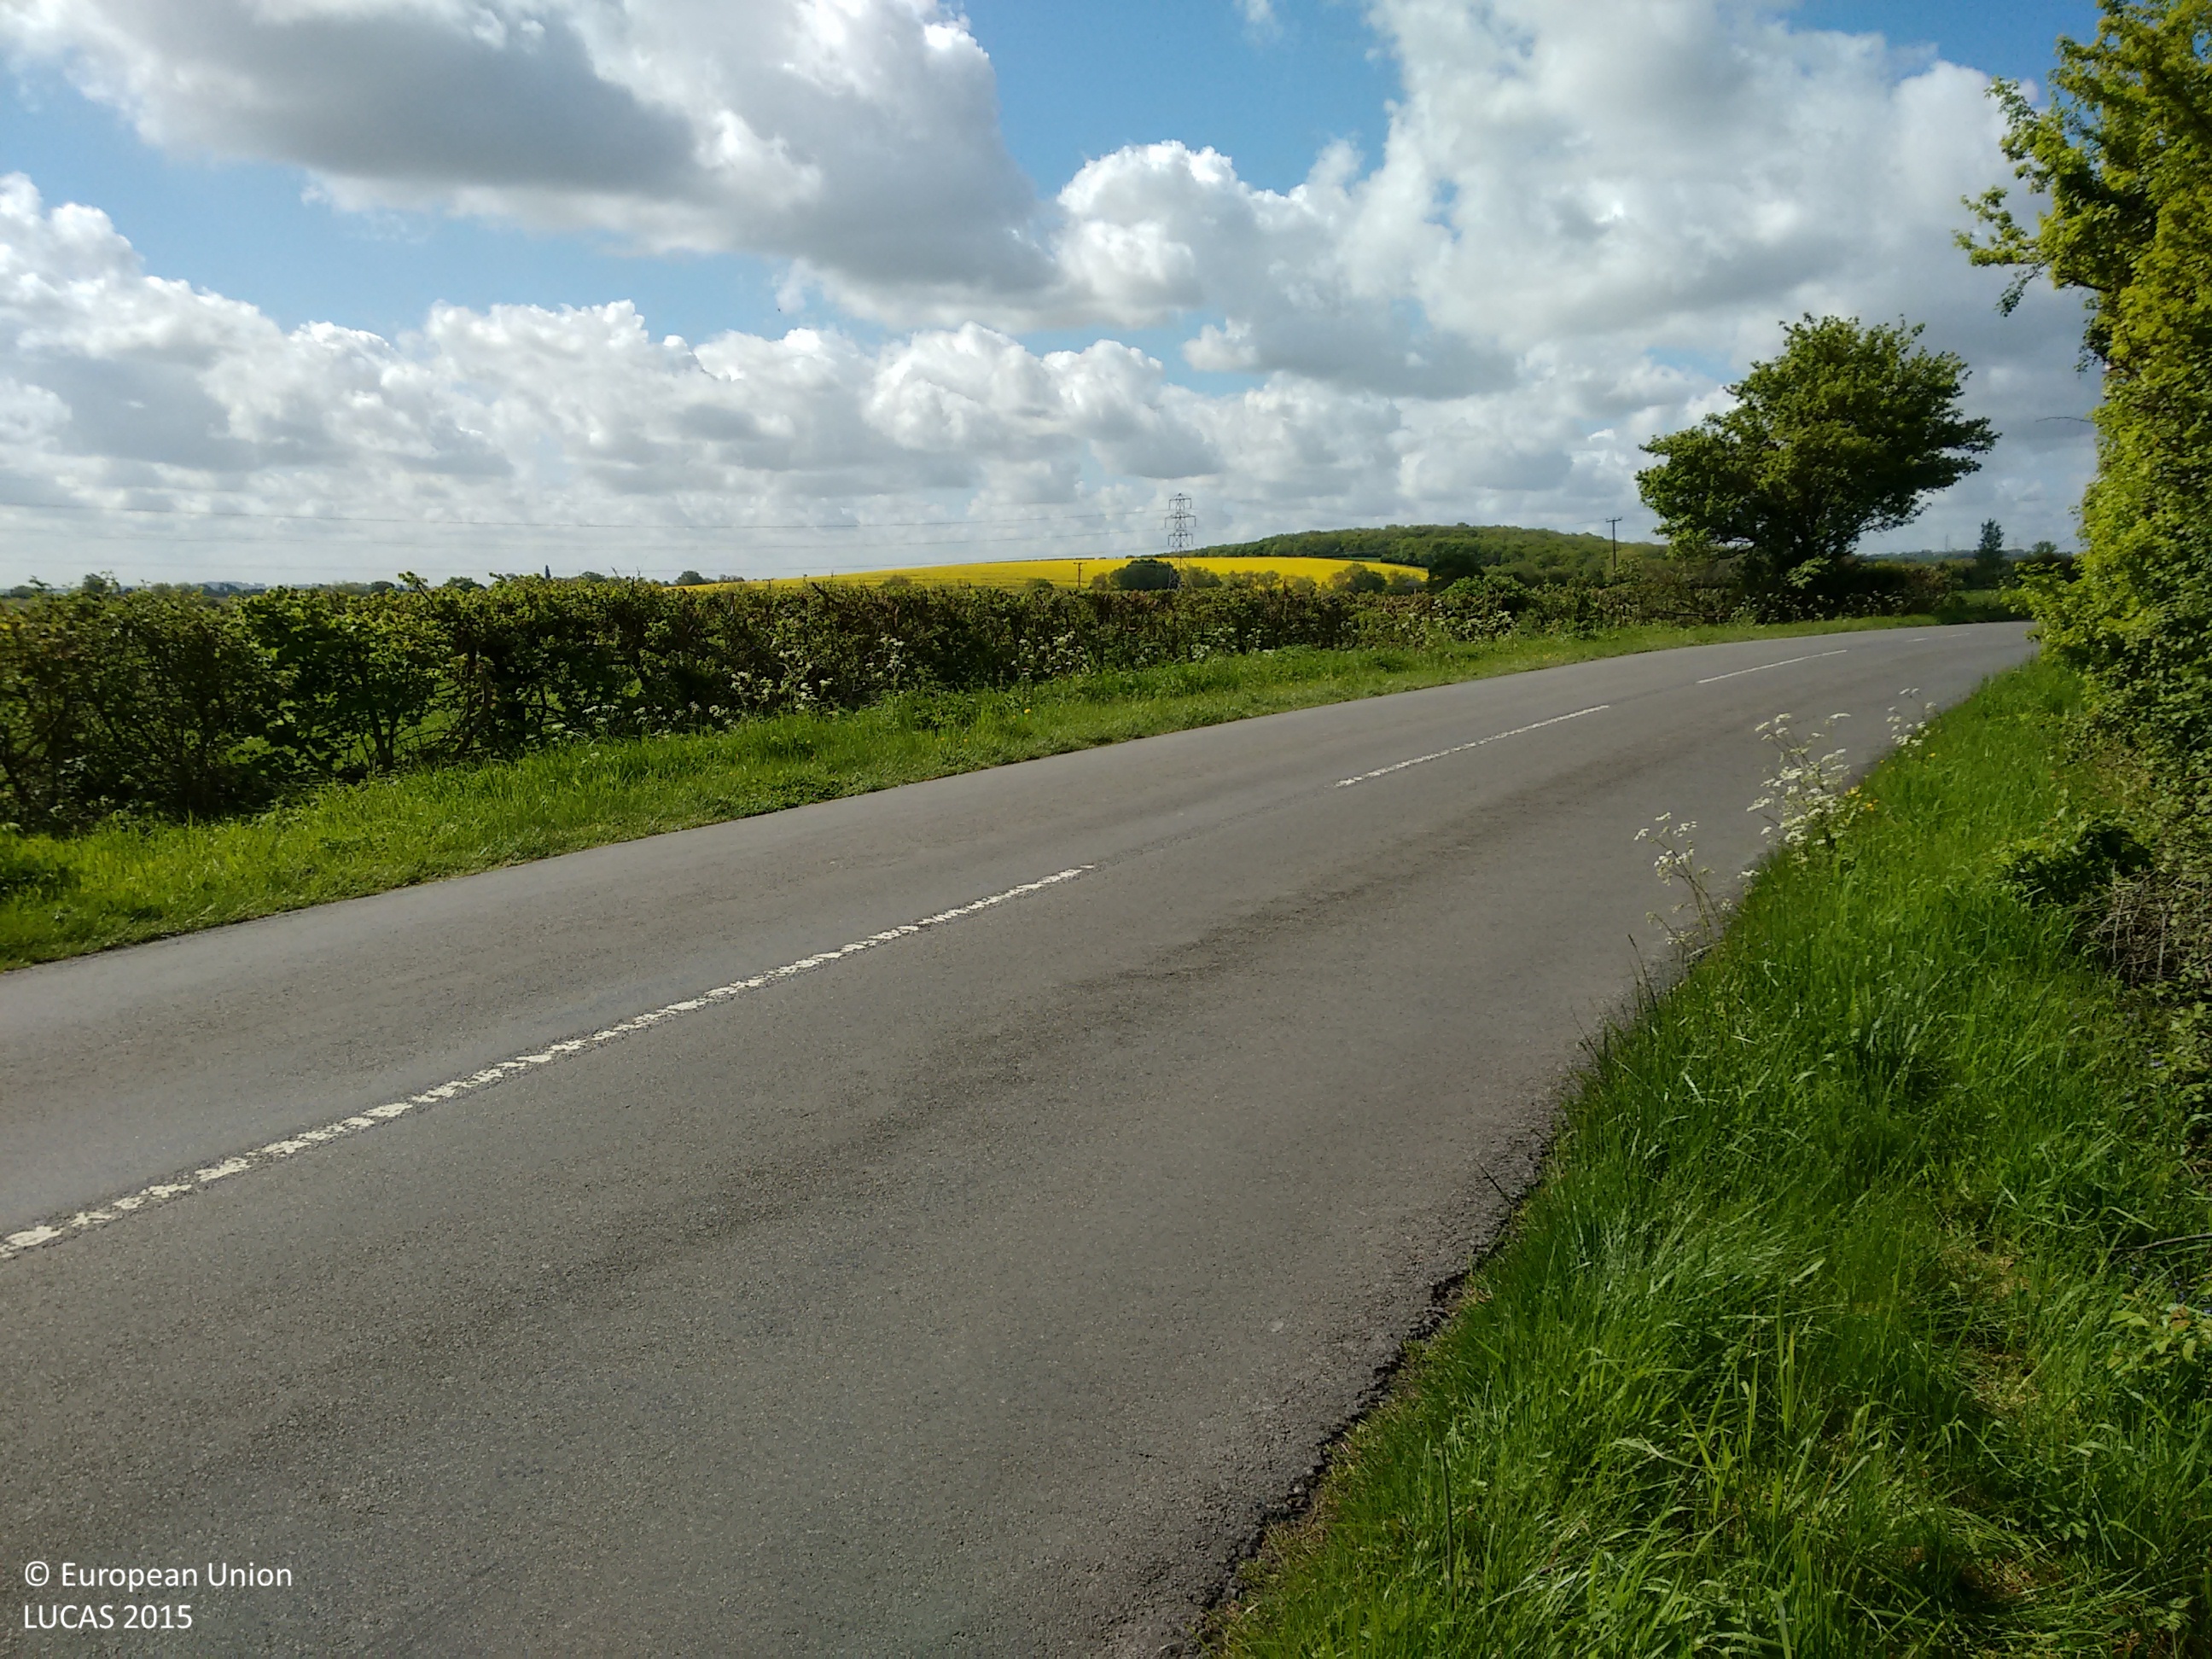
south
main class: Woodland
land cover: Broadleaved woodland
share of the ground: > 75 %
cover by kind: broadleaved forest trees 80 %, herbaceous plants 20 %
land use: Semi-natural and natural areas not in use
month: May
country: GB
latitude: 52.1244
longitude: -0.5408
